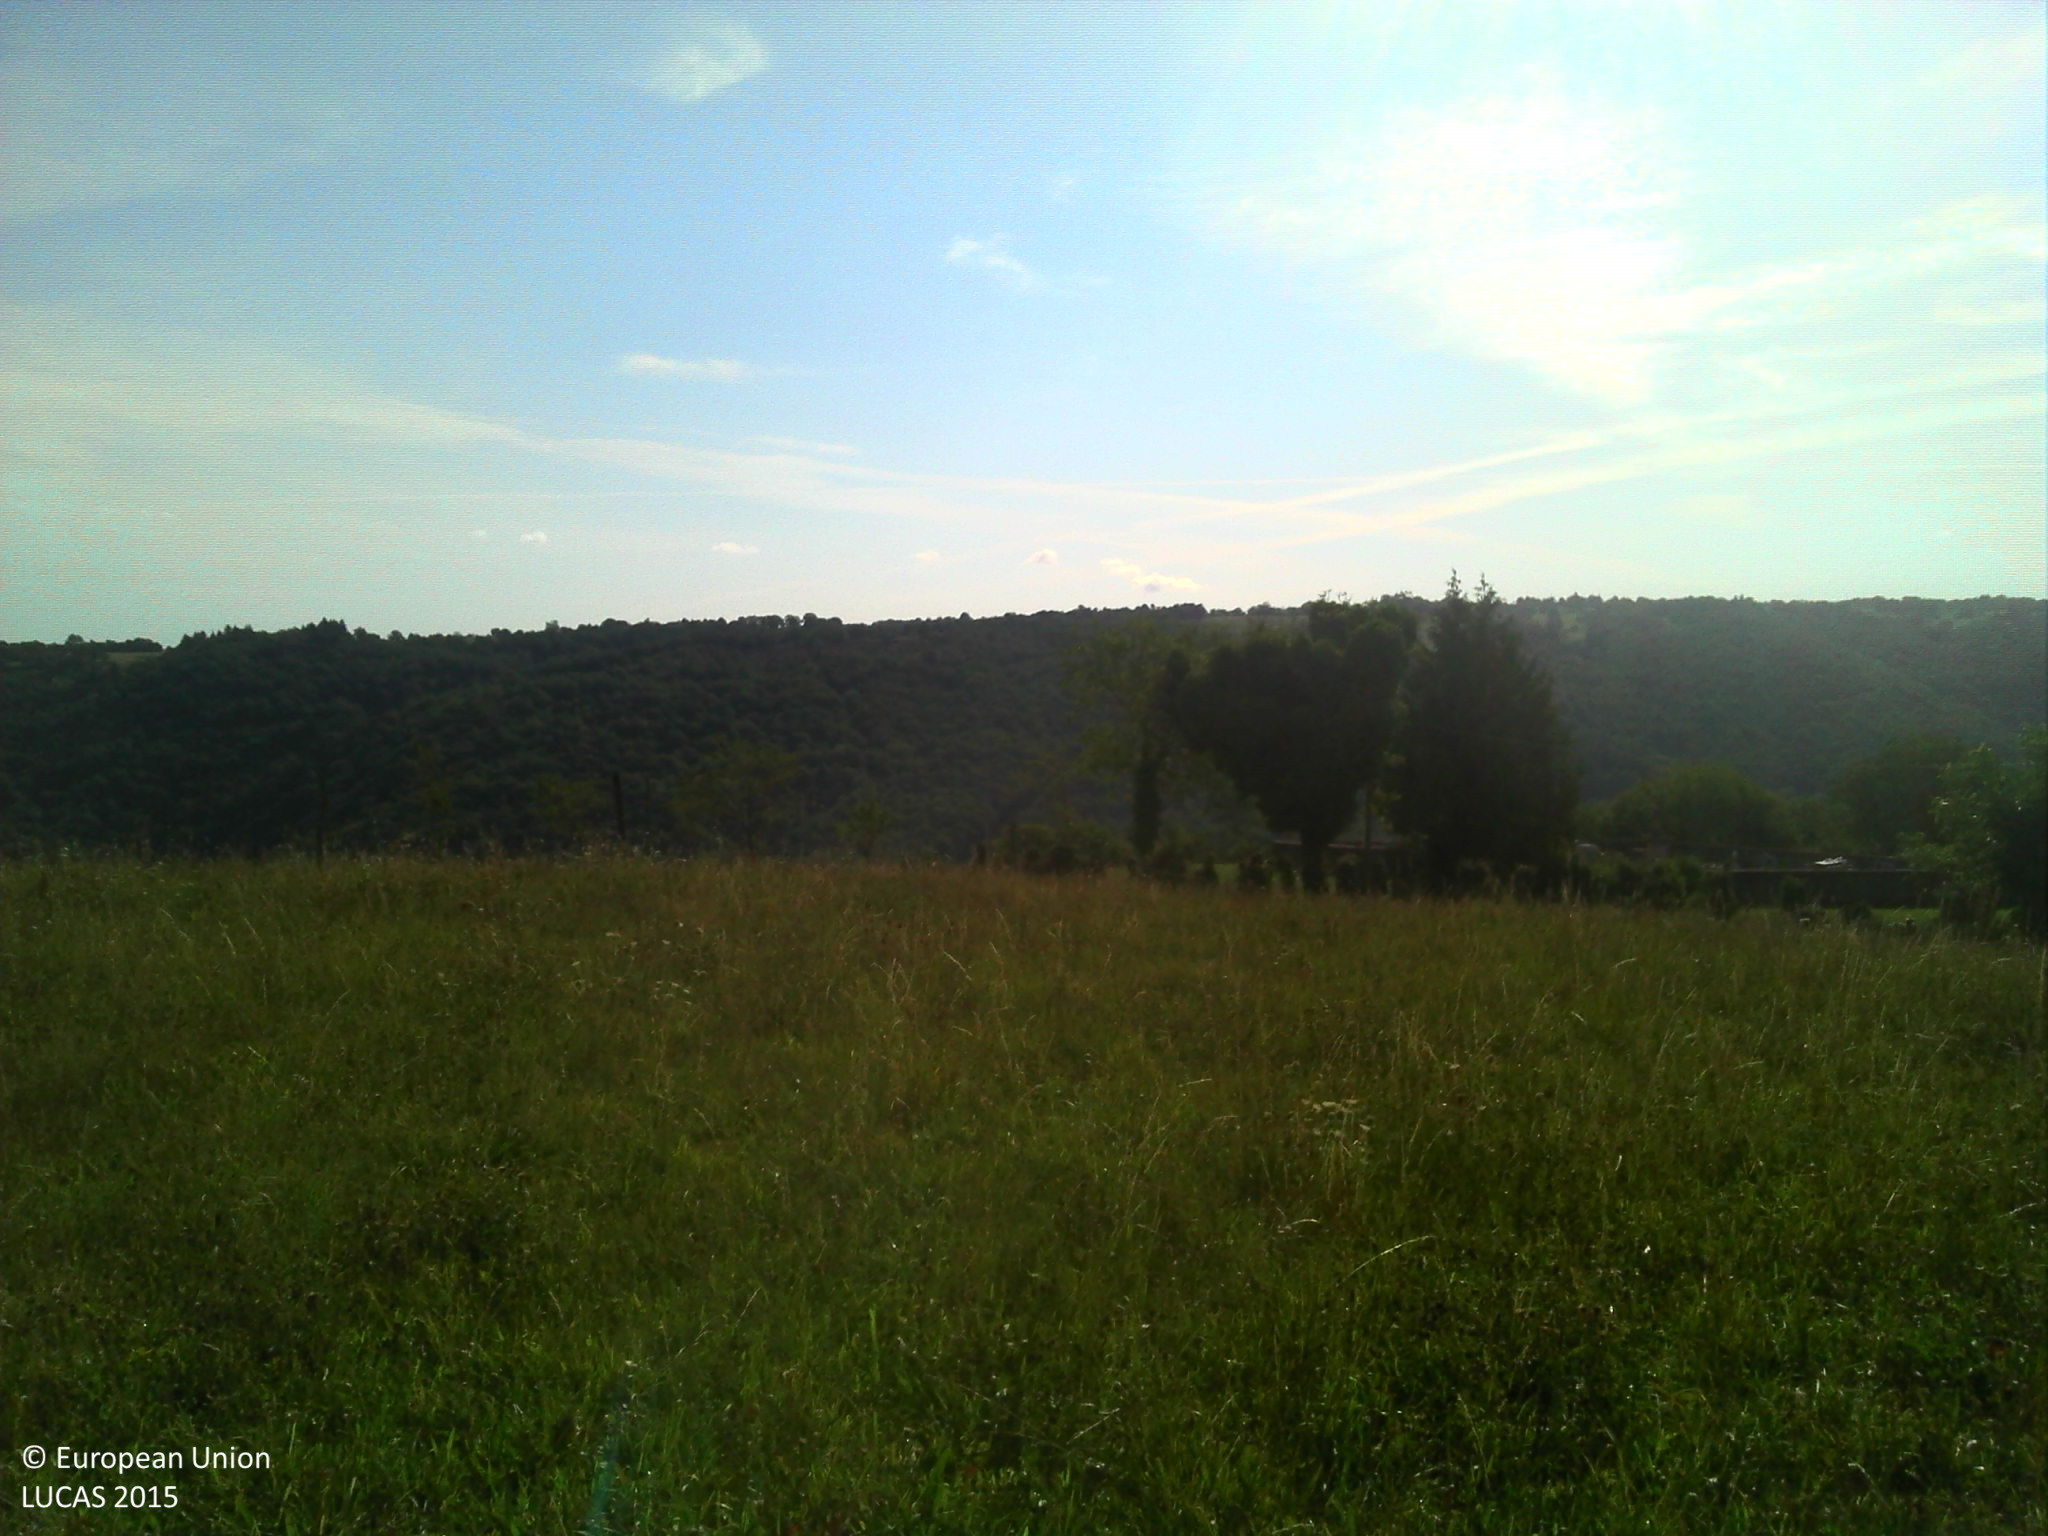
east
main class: Grassland
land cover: Grassland without tree/shrub cover
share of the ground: > 75 %
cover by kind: herbaceous plants 100 %
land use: Agriculture (excluding fallow land and kitchen gardens)
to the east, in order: Grassland without tree/shrub cover; Fences; Grassland without tree/shrub cover; Single bushes/trees; Fences; Electric lines; Grass margins; Paved roads, cycling and walking lanes; Single bushes/trees; Fences; Grassland with sparse tree/shrub cover; Fences; Grassland without tree/shrub cover; Fences; Broadleaved woodland; Fences; Broadleaved woodland
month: August
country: FR
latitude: 44.8178
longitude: 1.9689
